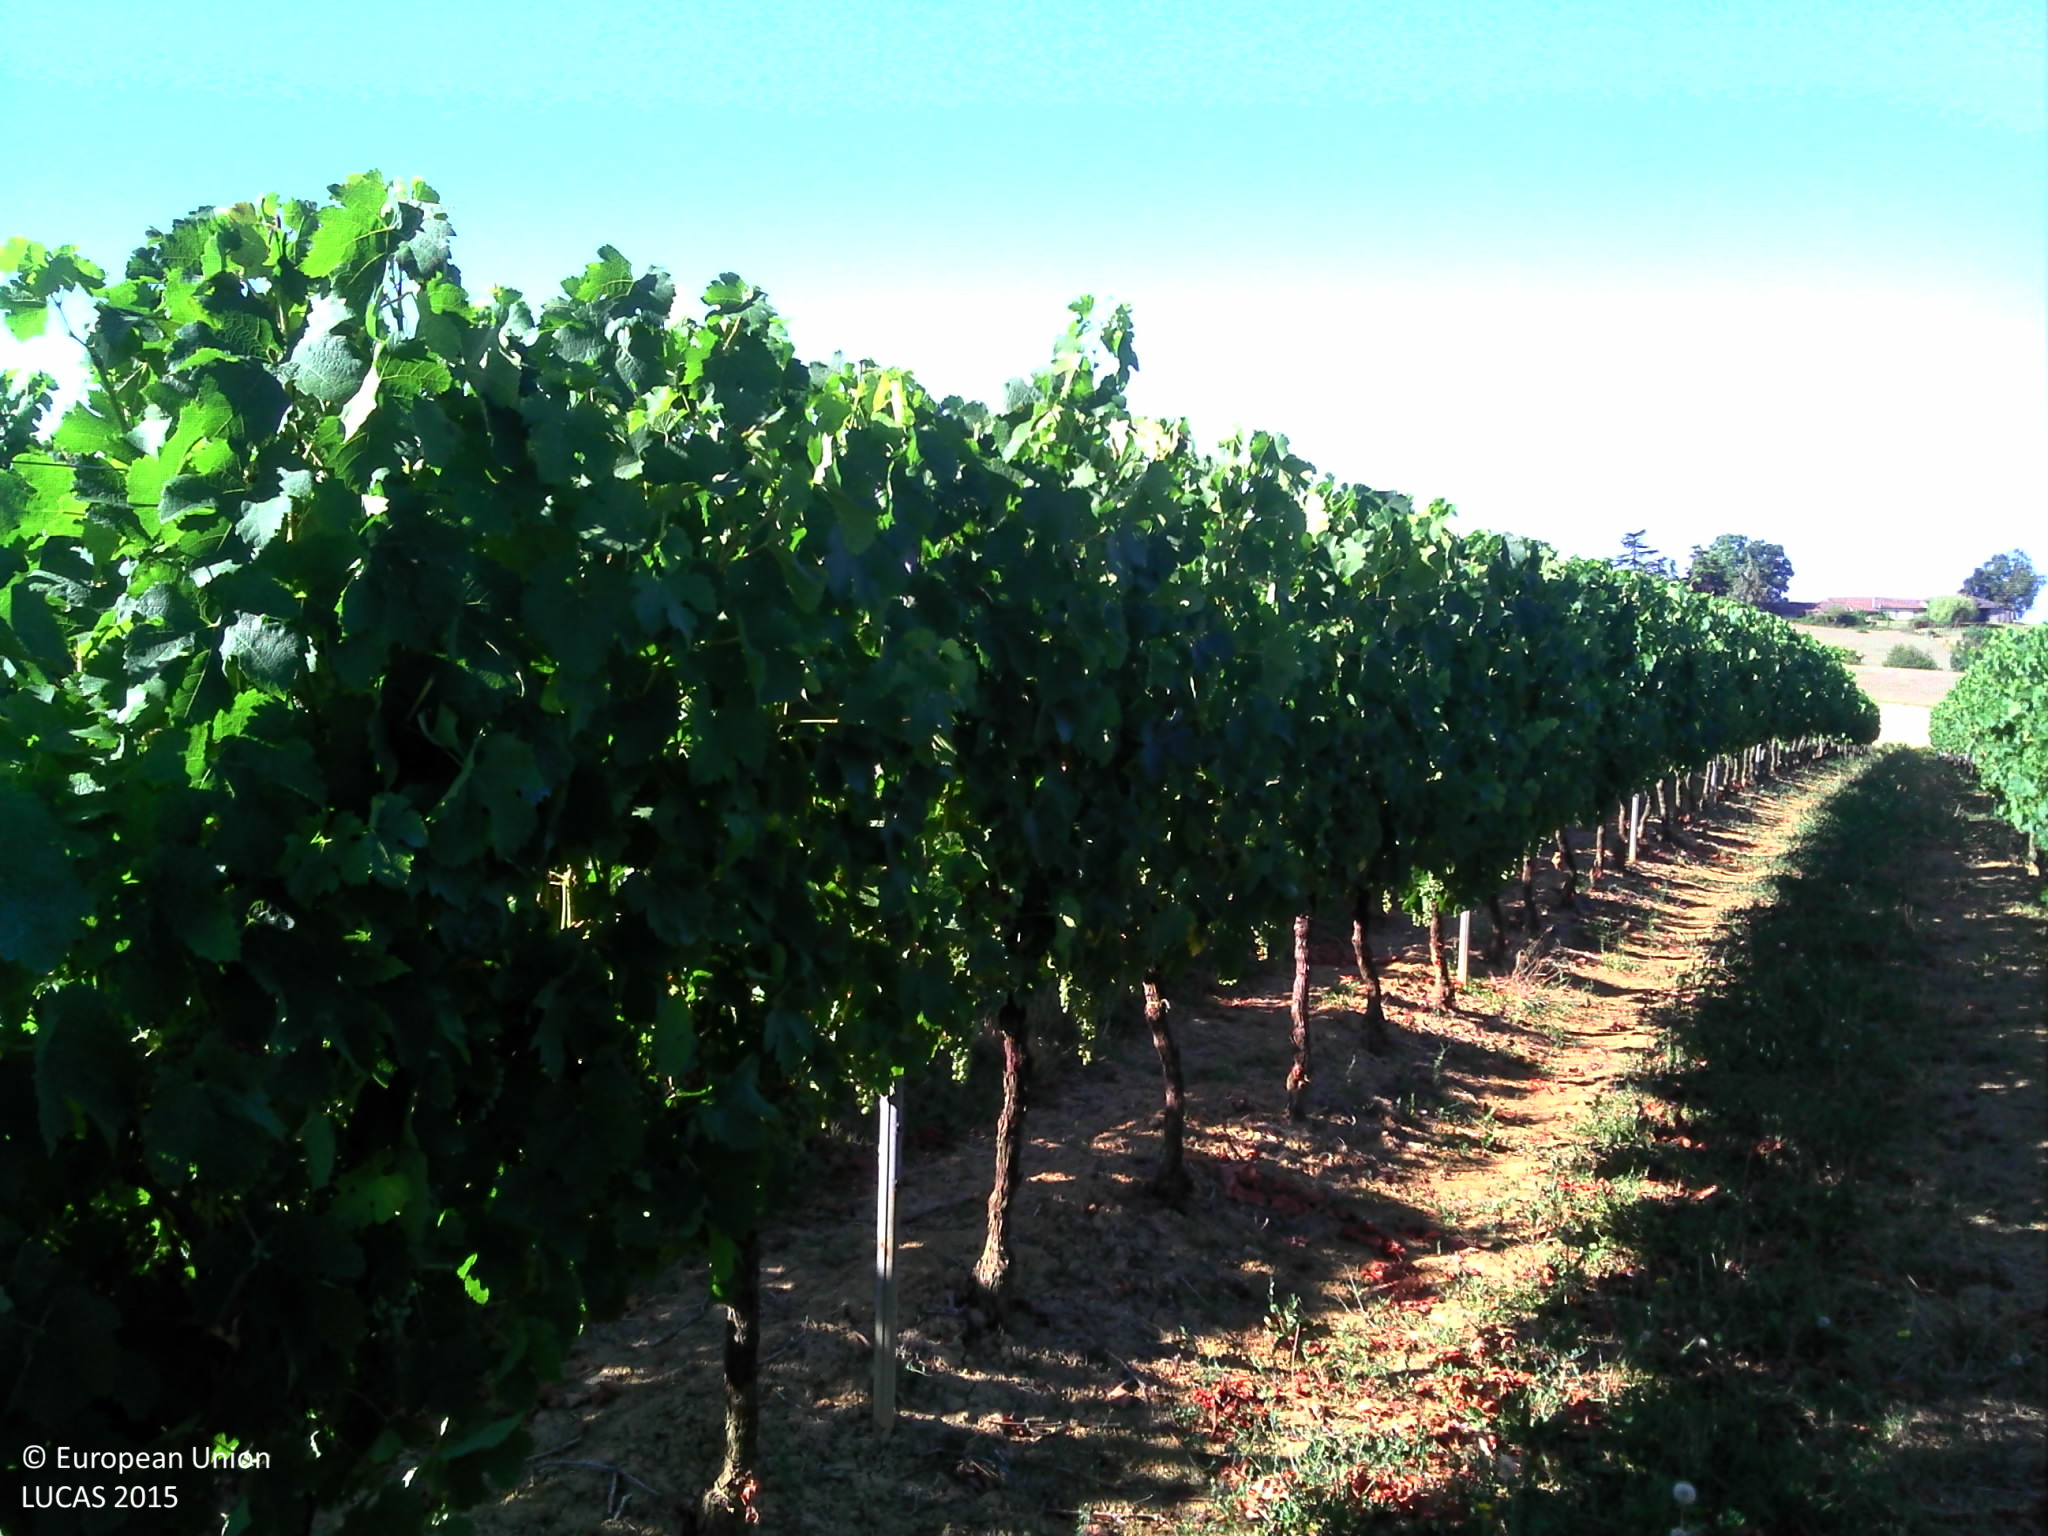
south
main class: Cropland
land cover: Vineyards
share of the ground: 10 - 25 %
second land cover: Grassland without tree/shrub cover
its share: 10 - 25 %
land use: Agriculture (excluding fallow land and kitchen gardens)
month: July
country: FR
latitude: 44.5347
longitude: 0.5414
